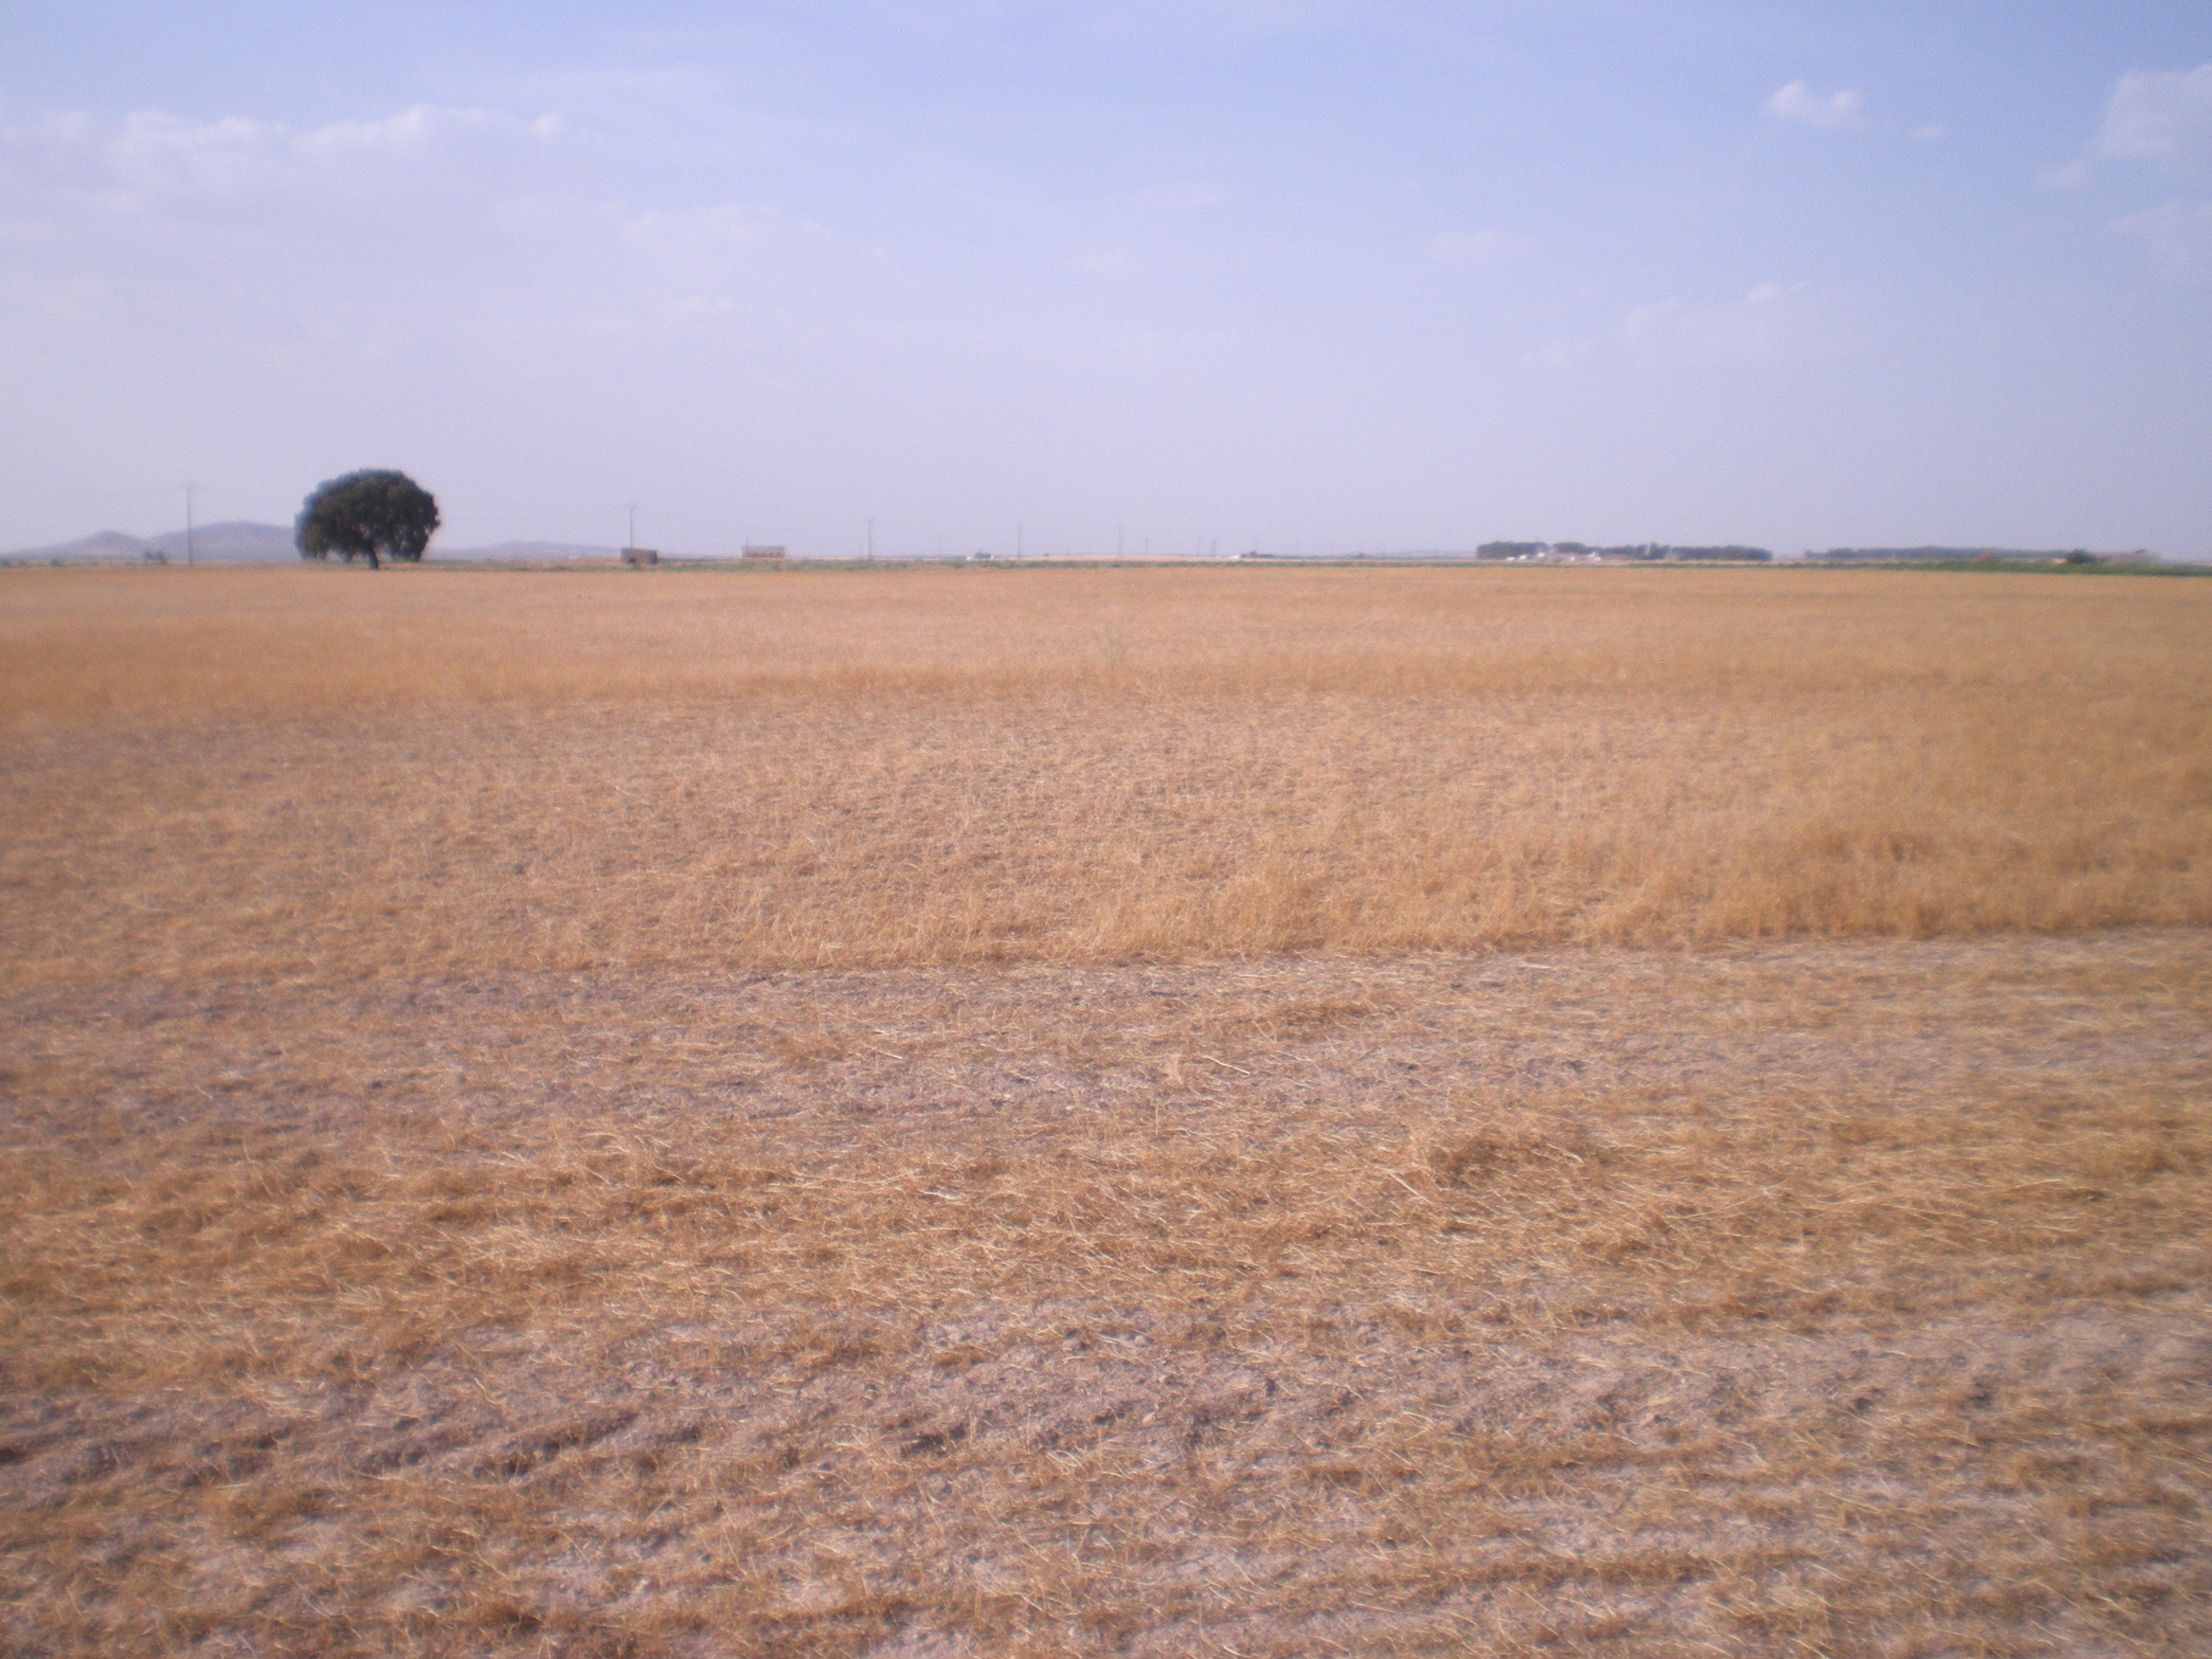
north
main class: Cropland
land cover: Dry pulses
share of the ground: < 10 %
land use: Agriculture (excluding fallow land and kitchen gardens)
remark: Harvested field
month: July
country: ES
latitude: 39.2612
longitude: -3.3337
